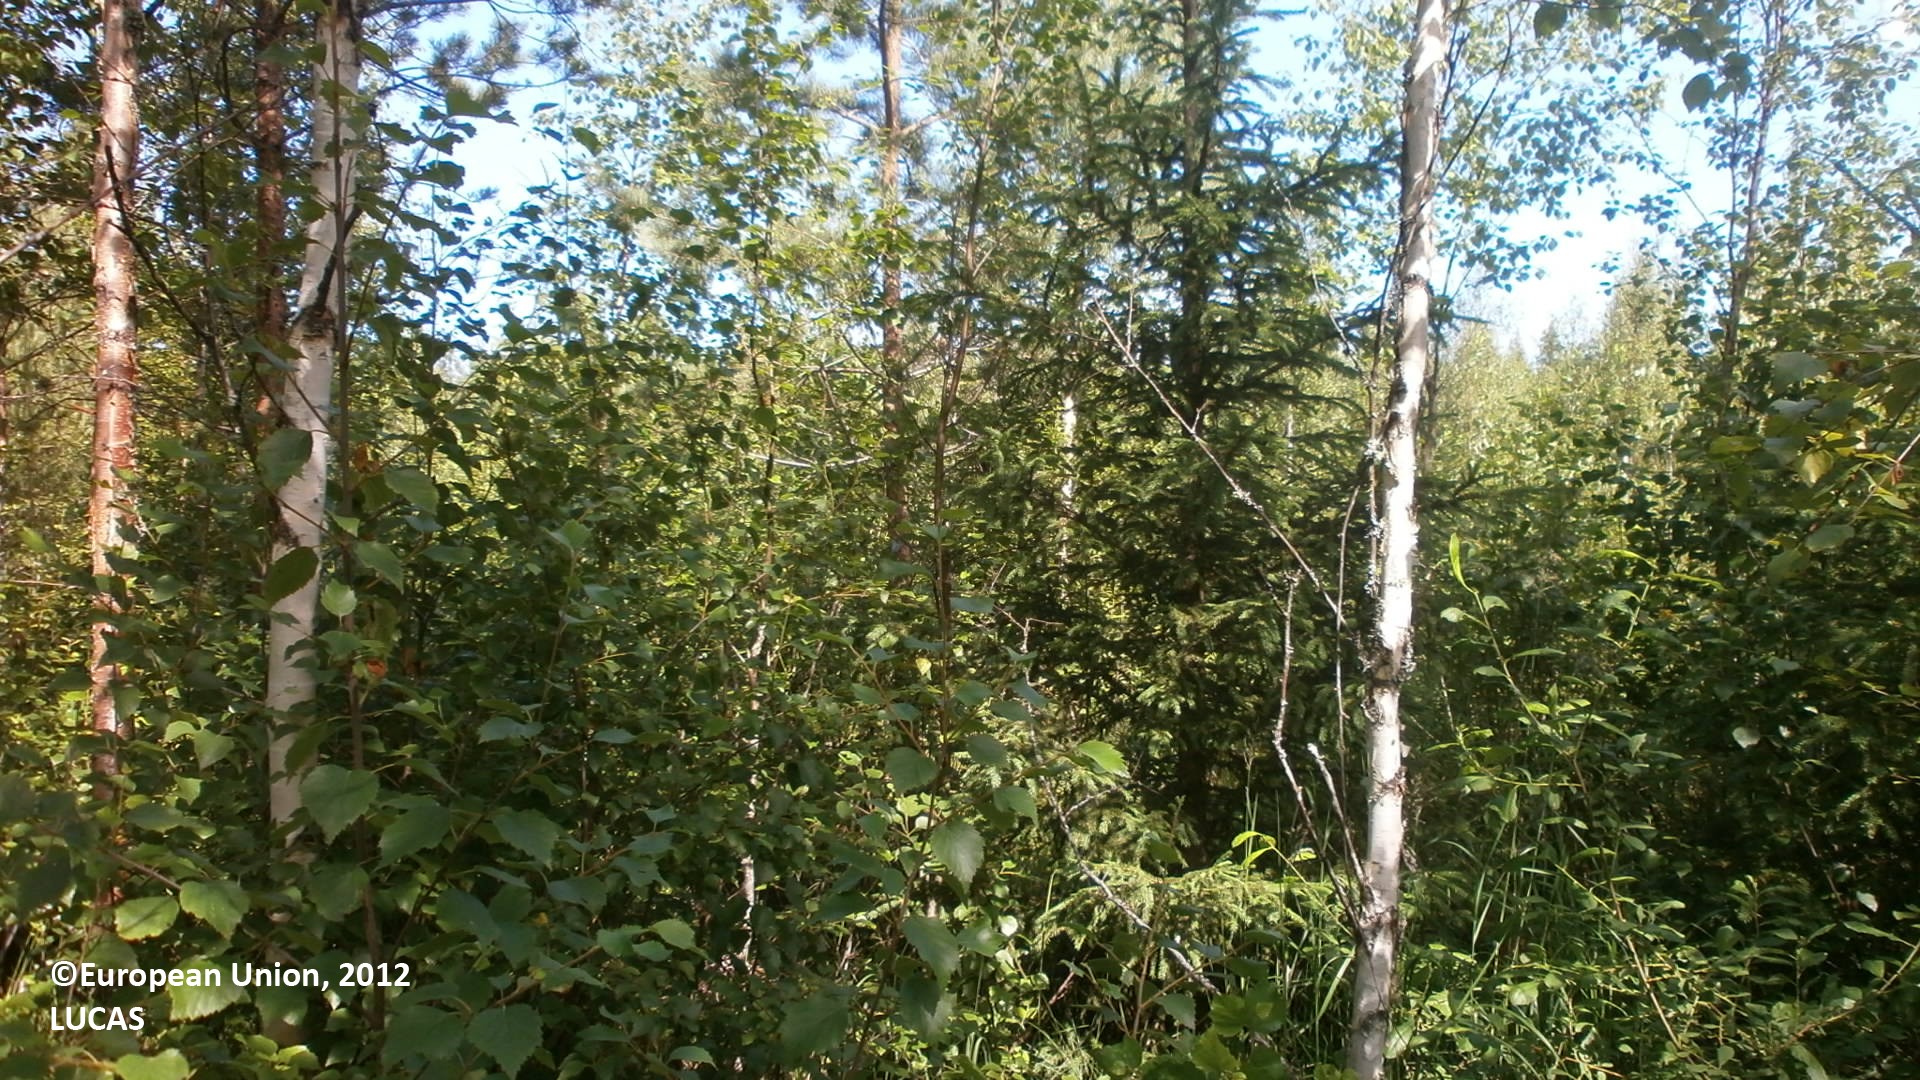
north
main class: Woodland
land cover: Other mixed woodland
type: boreal forest
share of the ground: > 75 %
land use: Forestry
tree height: > 5 m
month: July
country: FI
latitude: 64.3126
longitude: 24.1458
